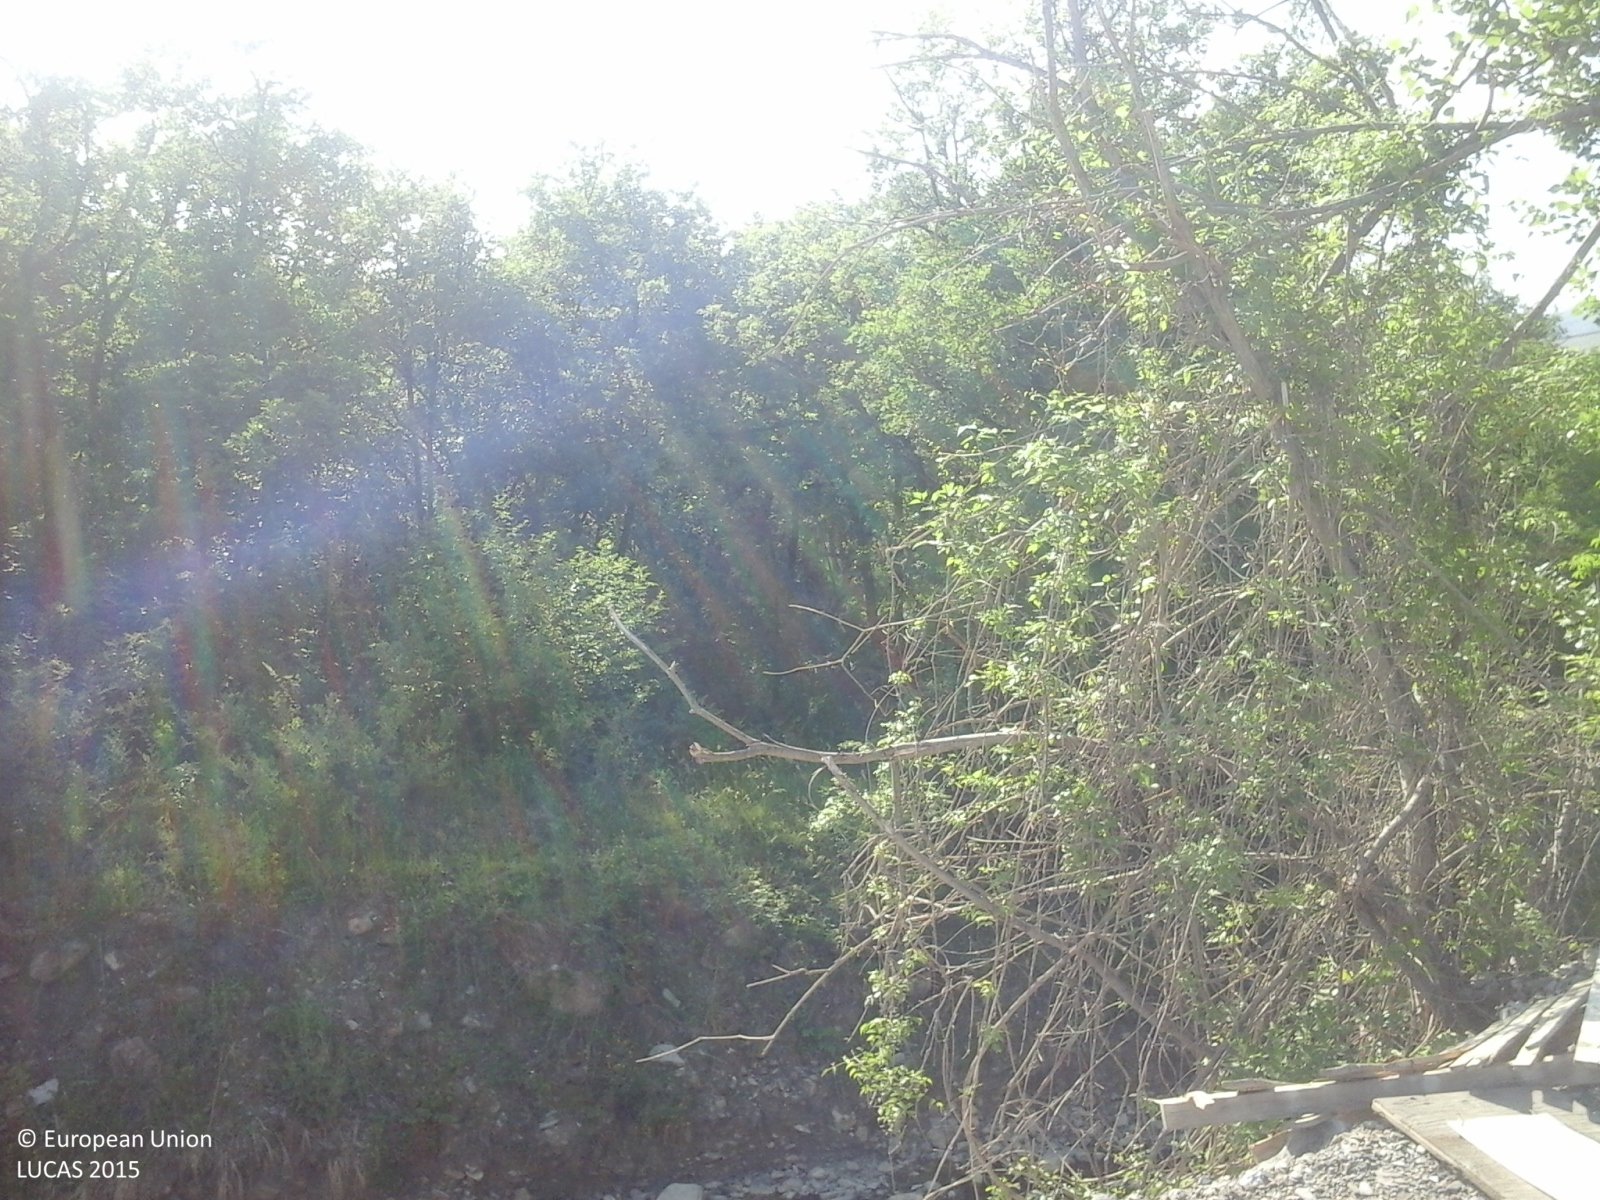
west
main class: Woodland
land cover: Broadleaved woodland
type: thermophilous deciduous forest
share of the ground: > 75 %
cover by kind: broadleaved forest trees 100 %
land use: Forestry
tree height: > 5 m
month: May
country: IT
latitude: 44.1838
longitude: 10.9609
